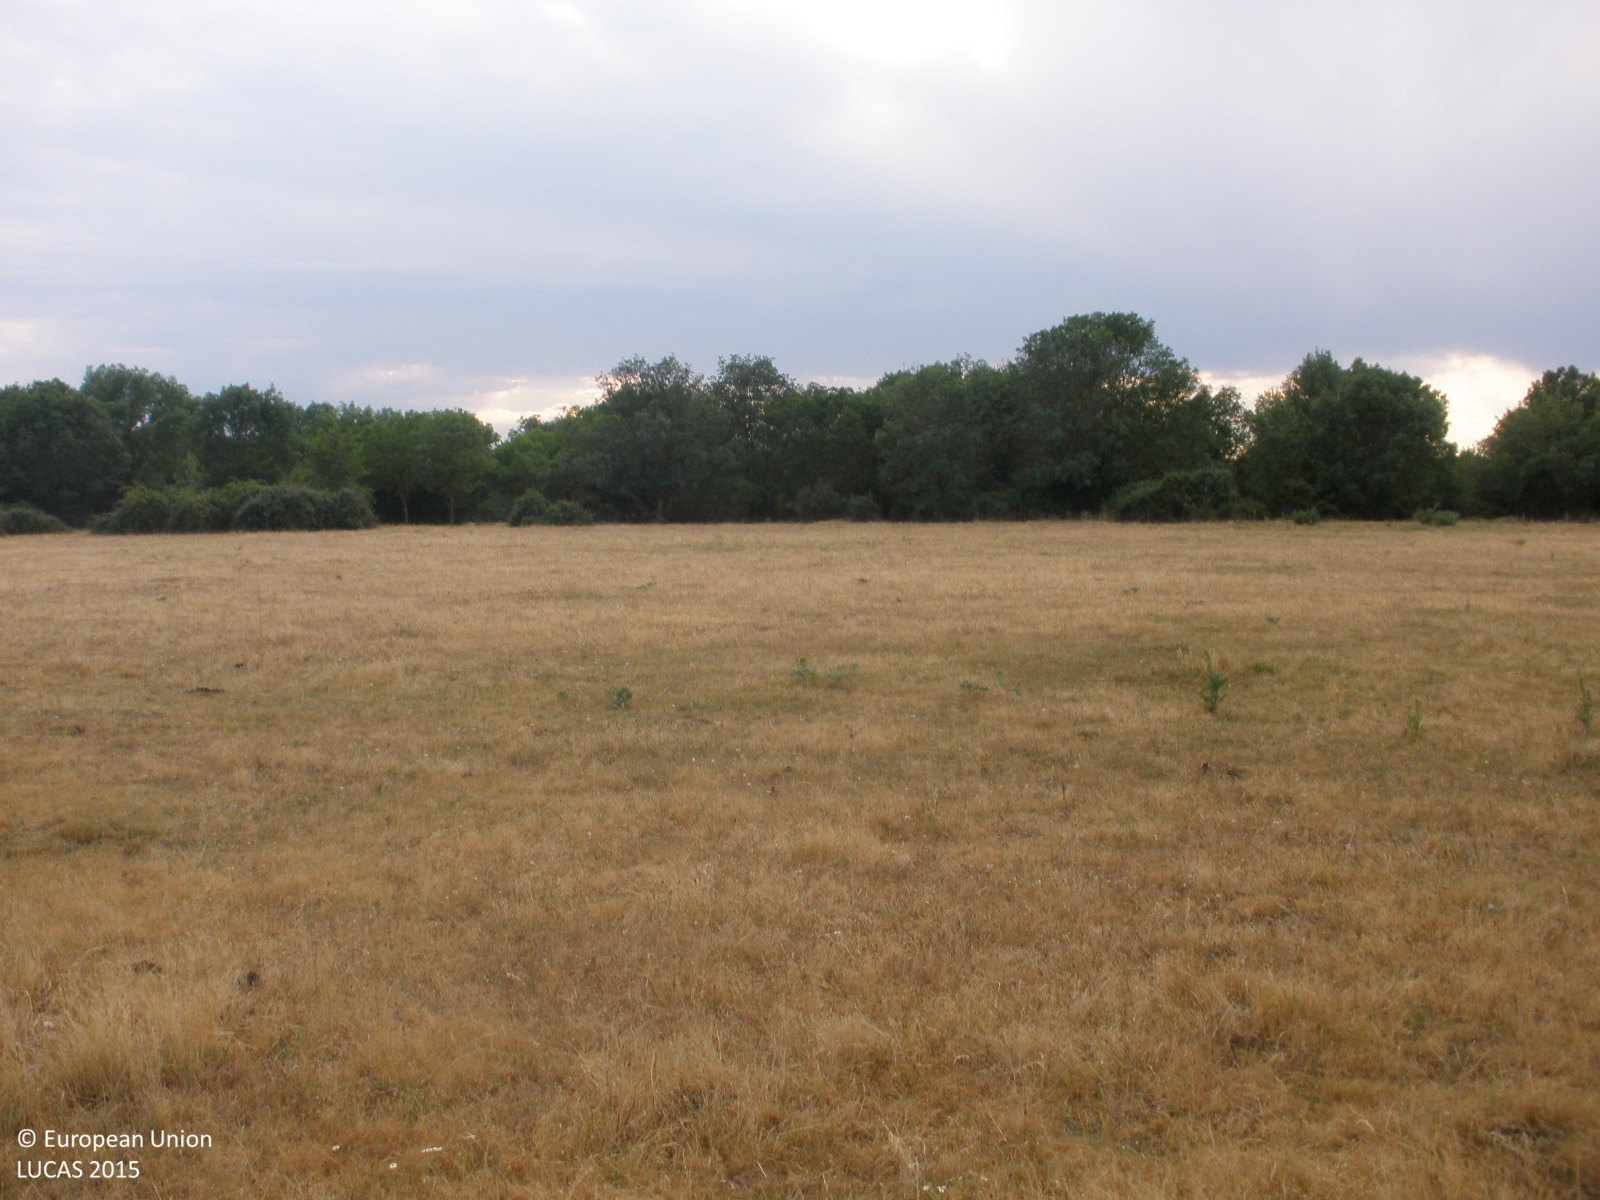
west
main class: Grassland
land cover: Grassland with sparse tree/shrub cover
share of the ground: > 75 %
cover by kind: herbaceous plants 85 %, shrubs 10 %, broadleaved forest trees 5 %
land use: Agriculture (excluding fallow land and kitchen gardens)
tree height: > 5 m
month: June
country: ES
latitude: 40.7097
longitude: -6.3391
